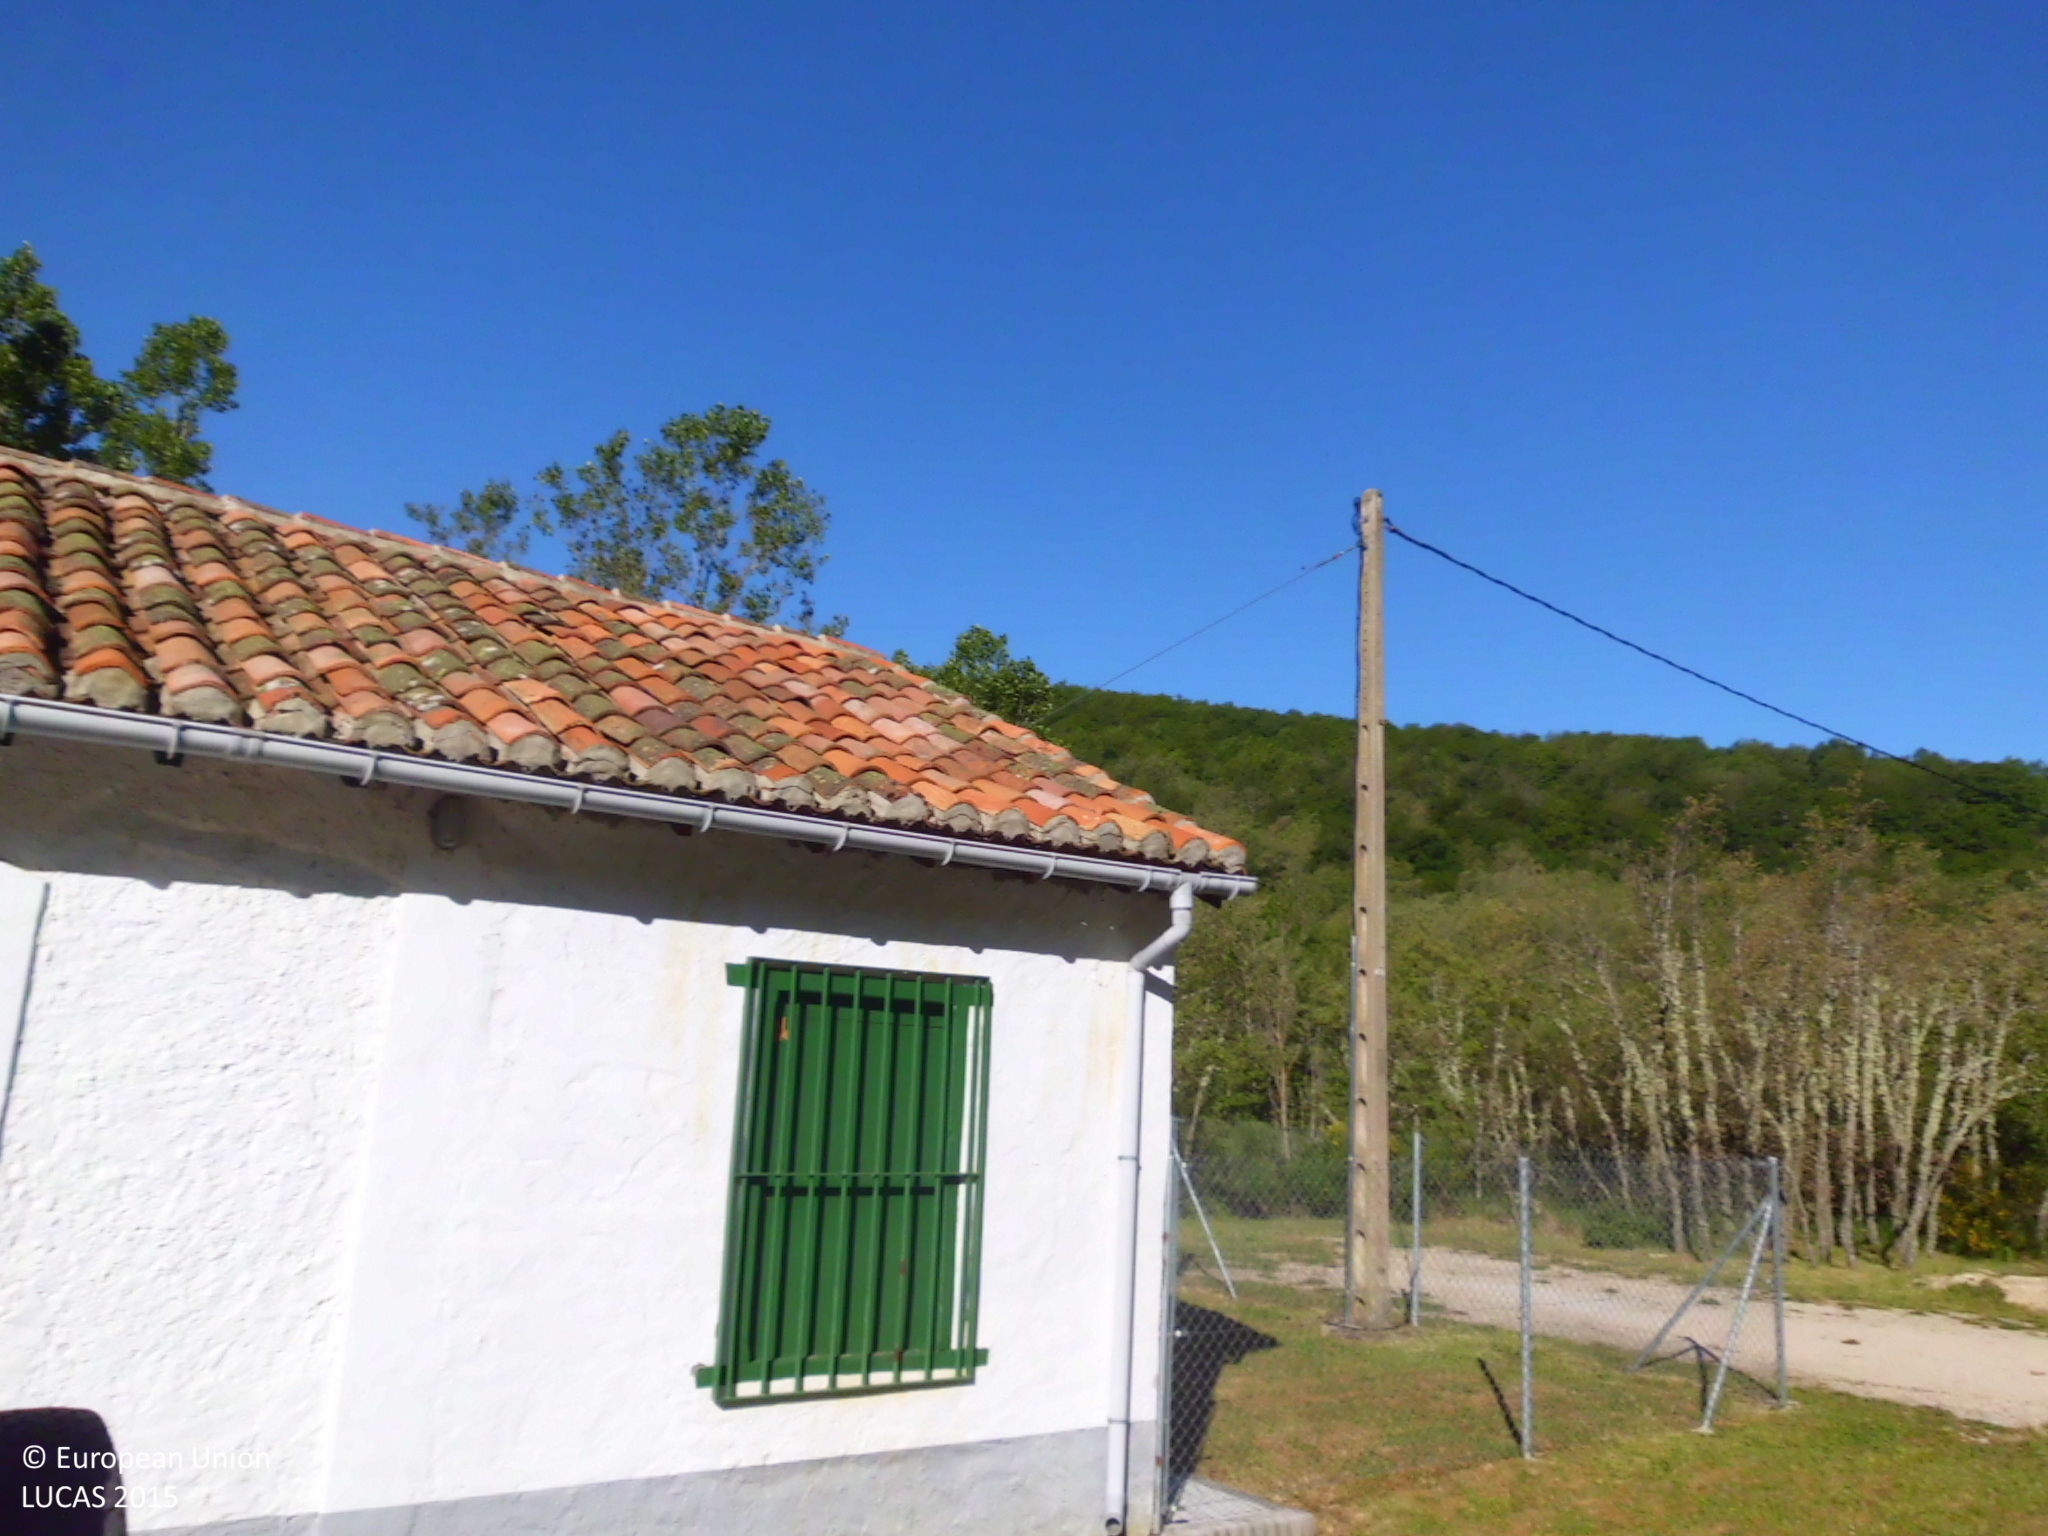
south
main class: Grassland
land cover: Grassland without tree/shrub cover
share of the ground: 50 - 75 %
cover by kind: herbaceous plants 55 %, consolidated bare surface 40 %, shrubs 5 %
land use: Semi-natural and natural areas not in use
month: May
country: ES
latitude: 42.9018
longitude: -4.5198
